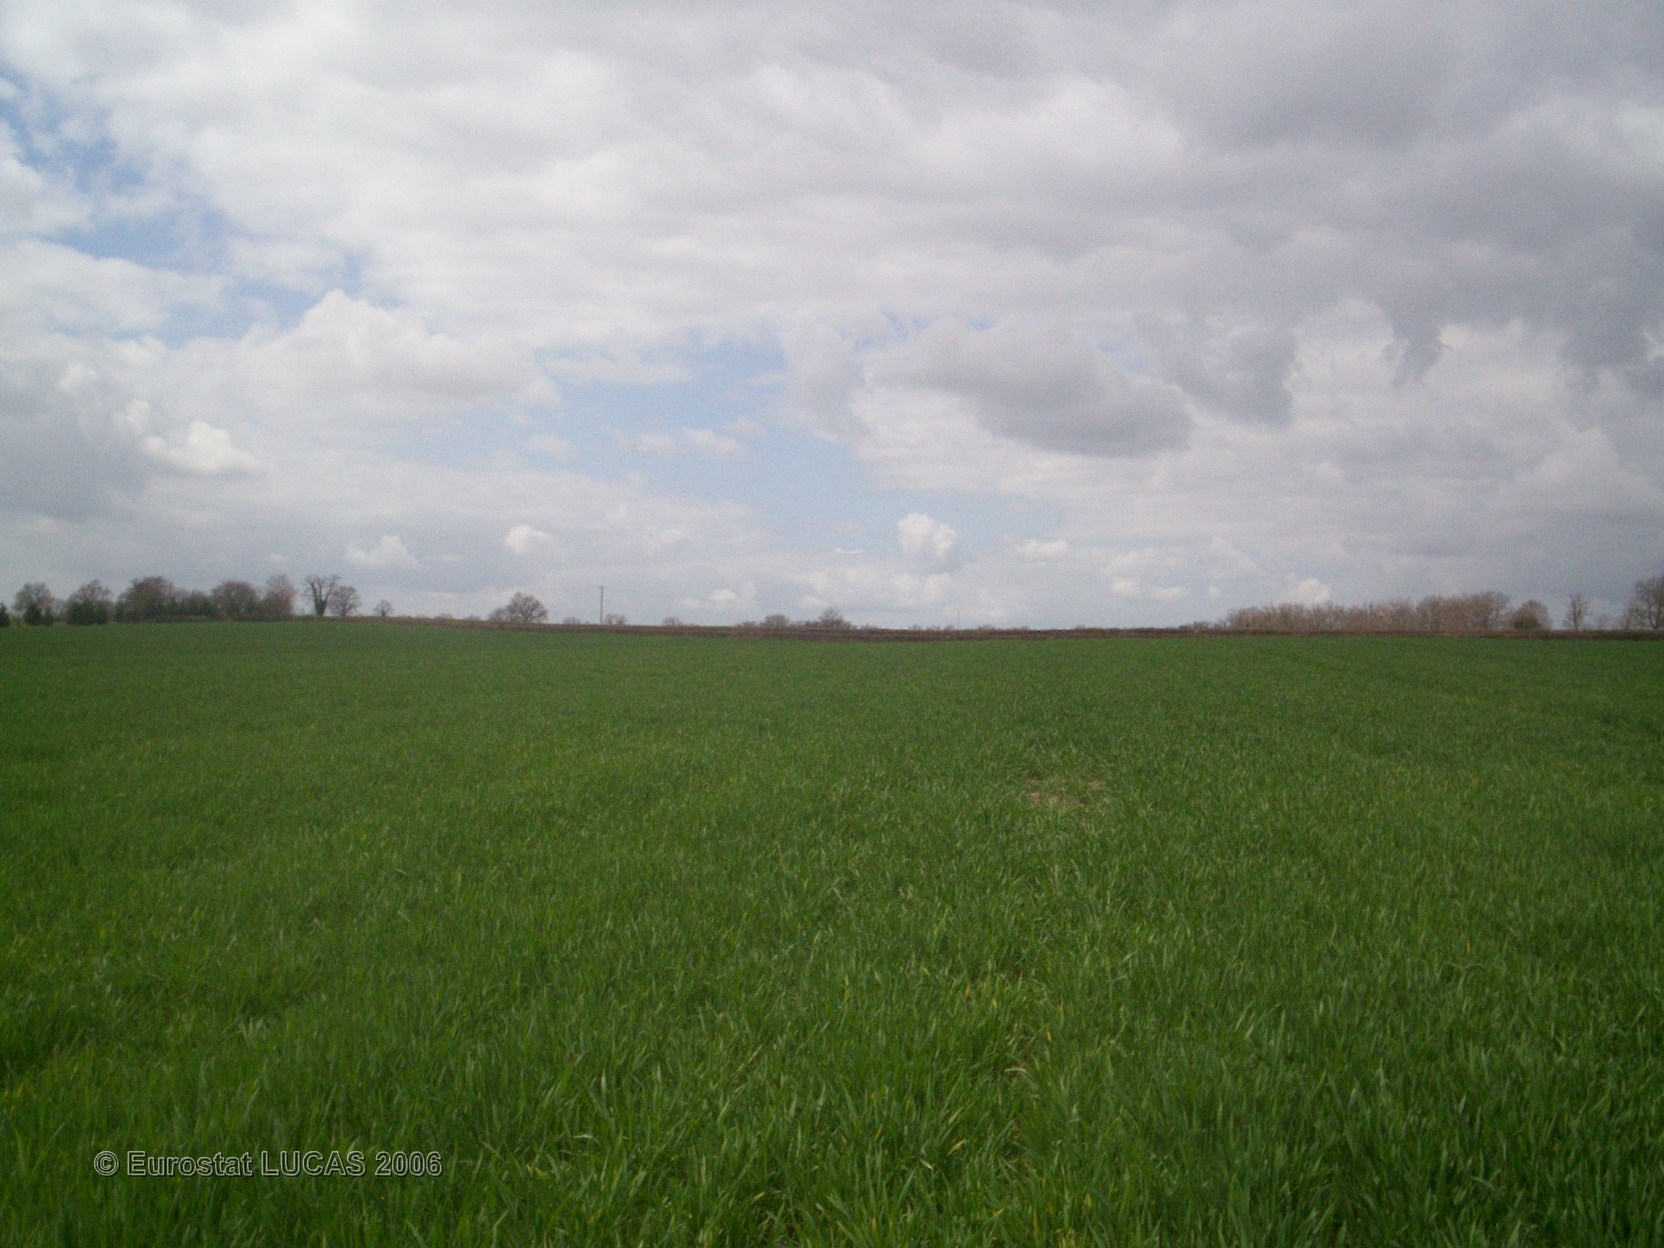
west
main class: Cropland
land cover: Common wheat
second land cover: Barley
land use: Agriculture (excluding fallow land and kitchen gardens)
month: April
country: FR
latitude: 46.4681
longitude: 1.0927
